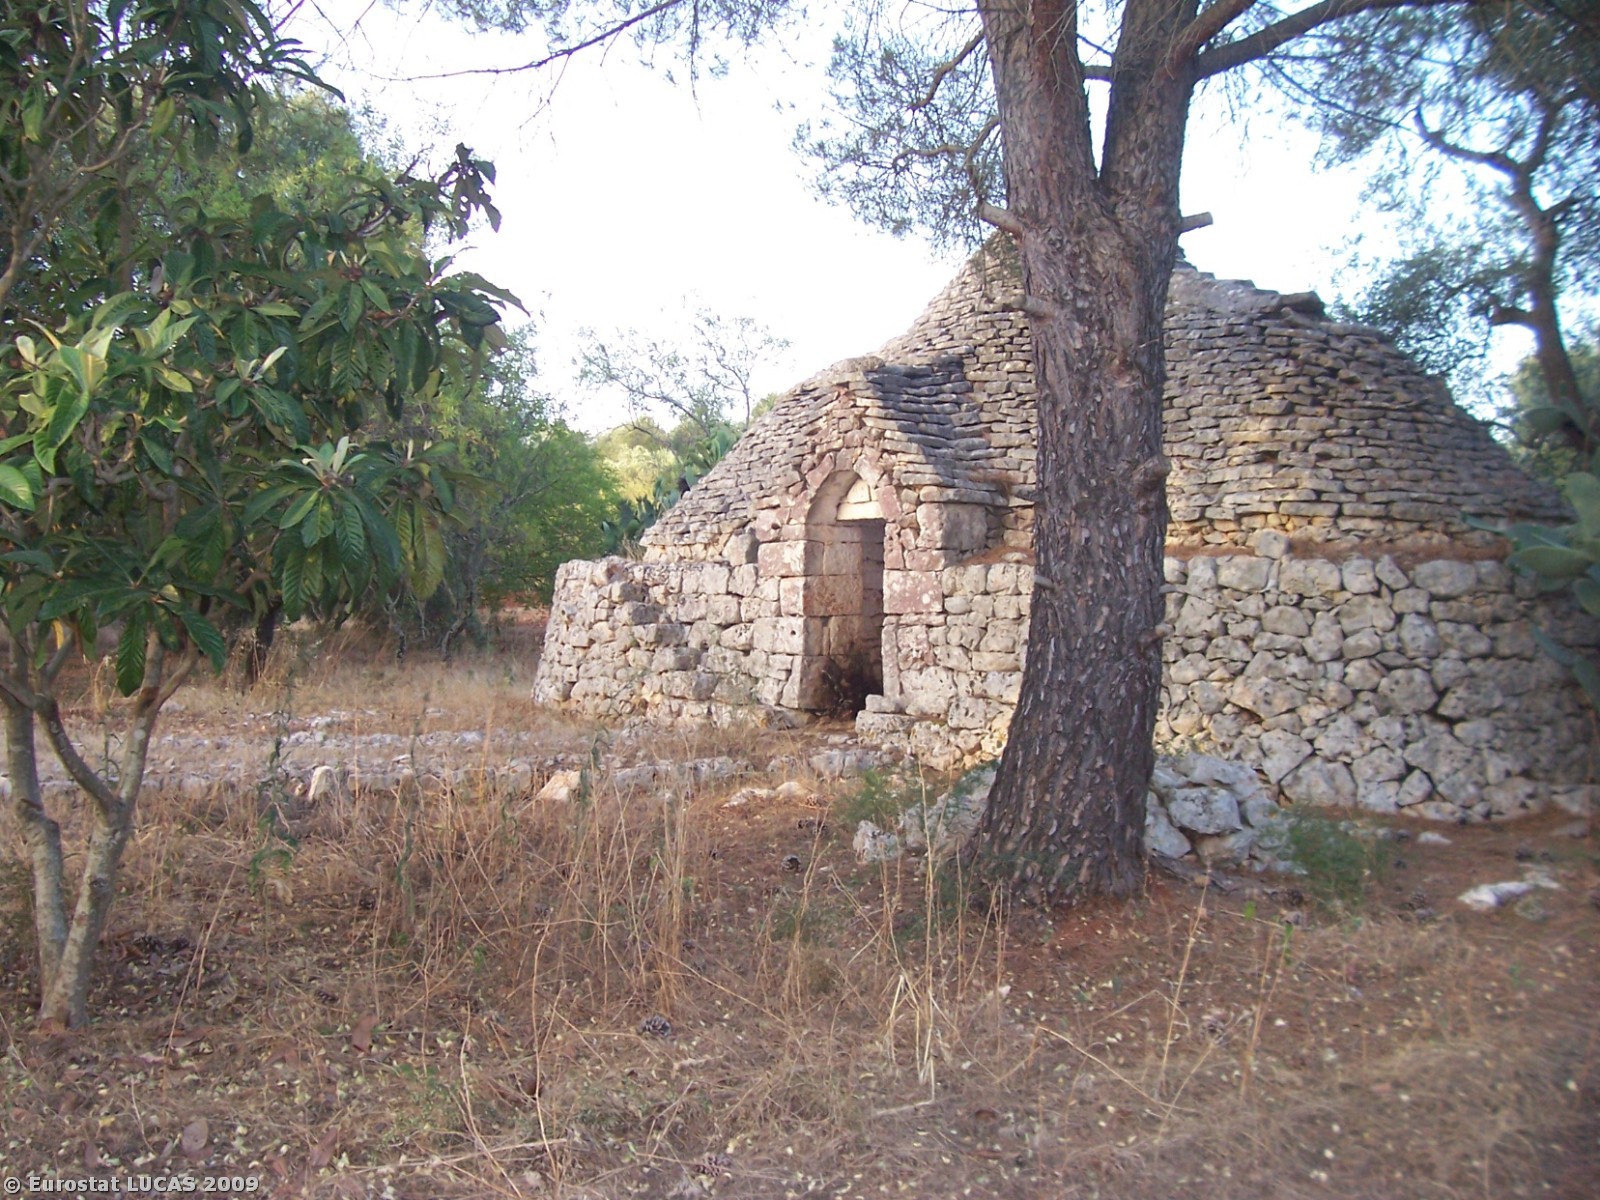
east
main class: Cropland
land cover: Nuts trees
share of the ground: 25 - 50 %
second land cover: Spontaneously vegetated surfaces
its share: > 75 %
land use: Agriculture (excluding fallow land and kitchen gardens)
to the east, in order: Nuts trees; Spontaneously vegetated surfaces; Artificial constructions in urban areas; Olive groves; Spontaneously vegetated surfaces; Tracks; Olive groves; Bare land; Artificial constructions in urban areas; Olive groves; Bare land; Dry stone walls; Paved roads, cycling and walking lanes; Dry stone walls; Olive groves; Bare land; Dry stone walls; Olive groves; Bare land
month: July
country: IT
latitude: 40.6656
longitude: 17.5592
